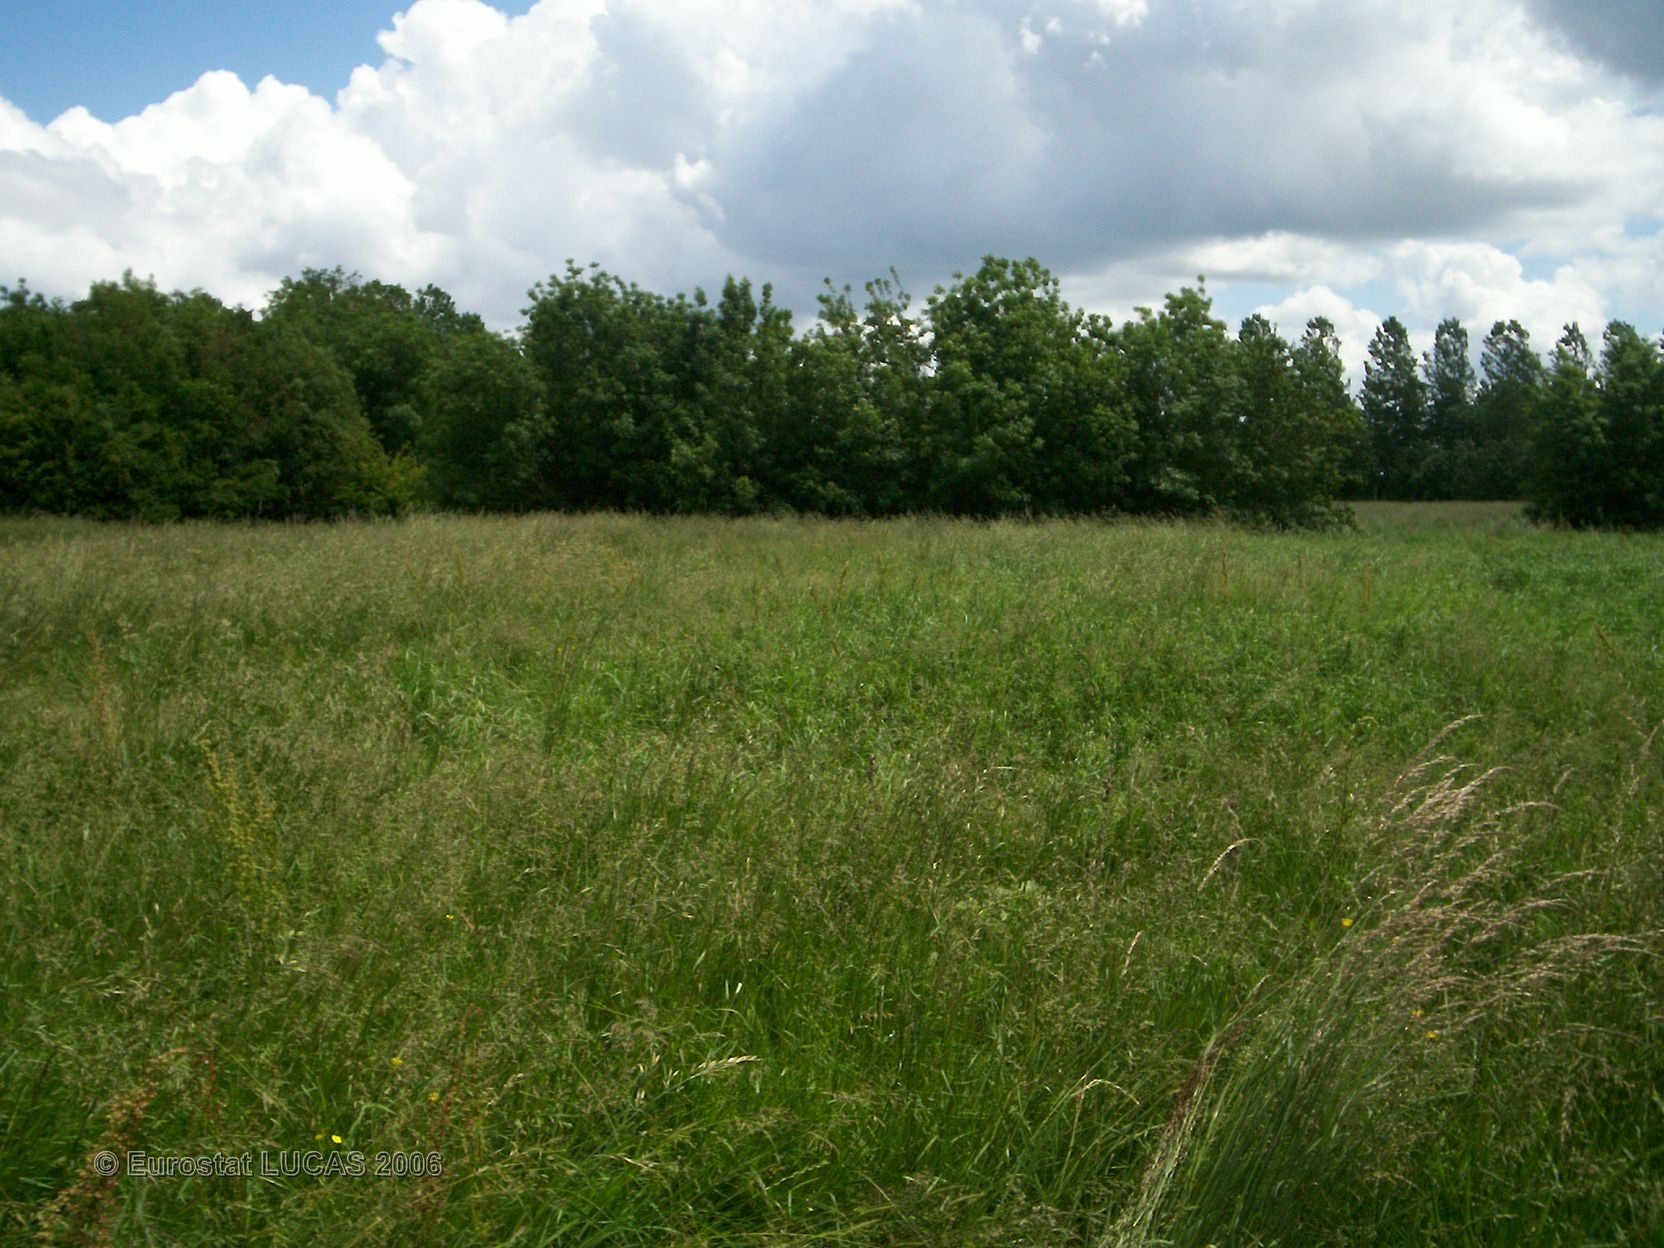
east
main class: Grassland
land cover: Grassland without tree/shrub cover
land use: Agriculture (excluding fallow land and kitchen gardens)
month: May
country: FR
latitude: 46.3475
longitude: -0.8010
